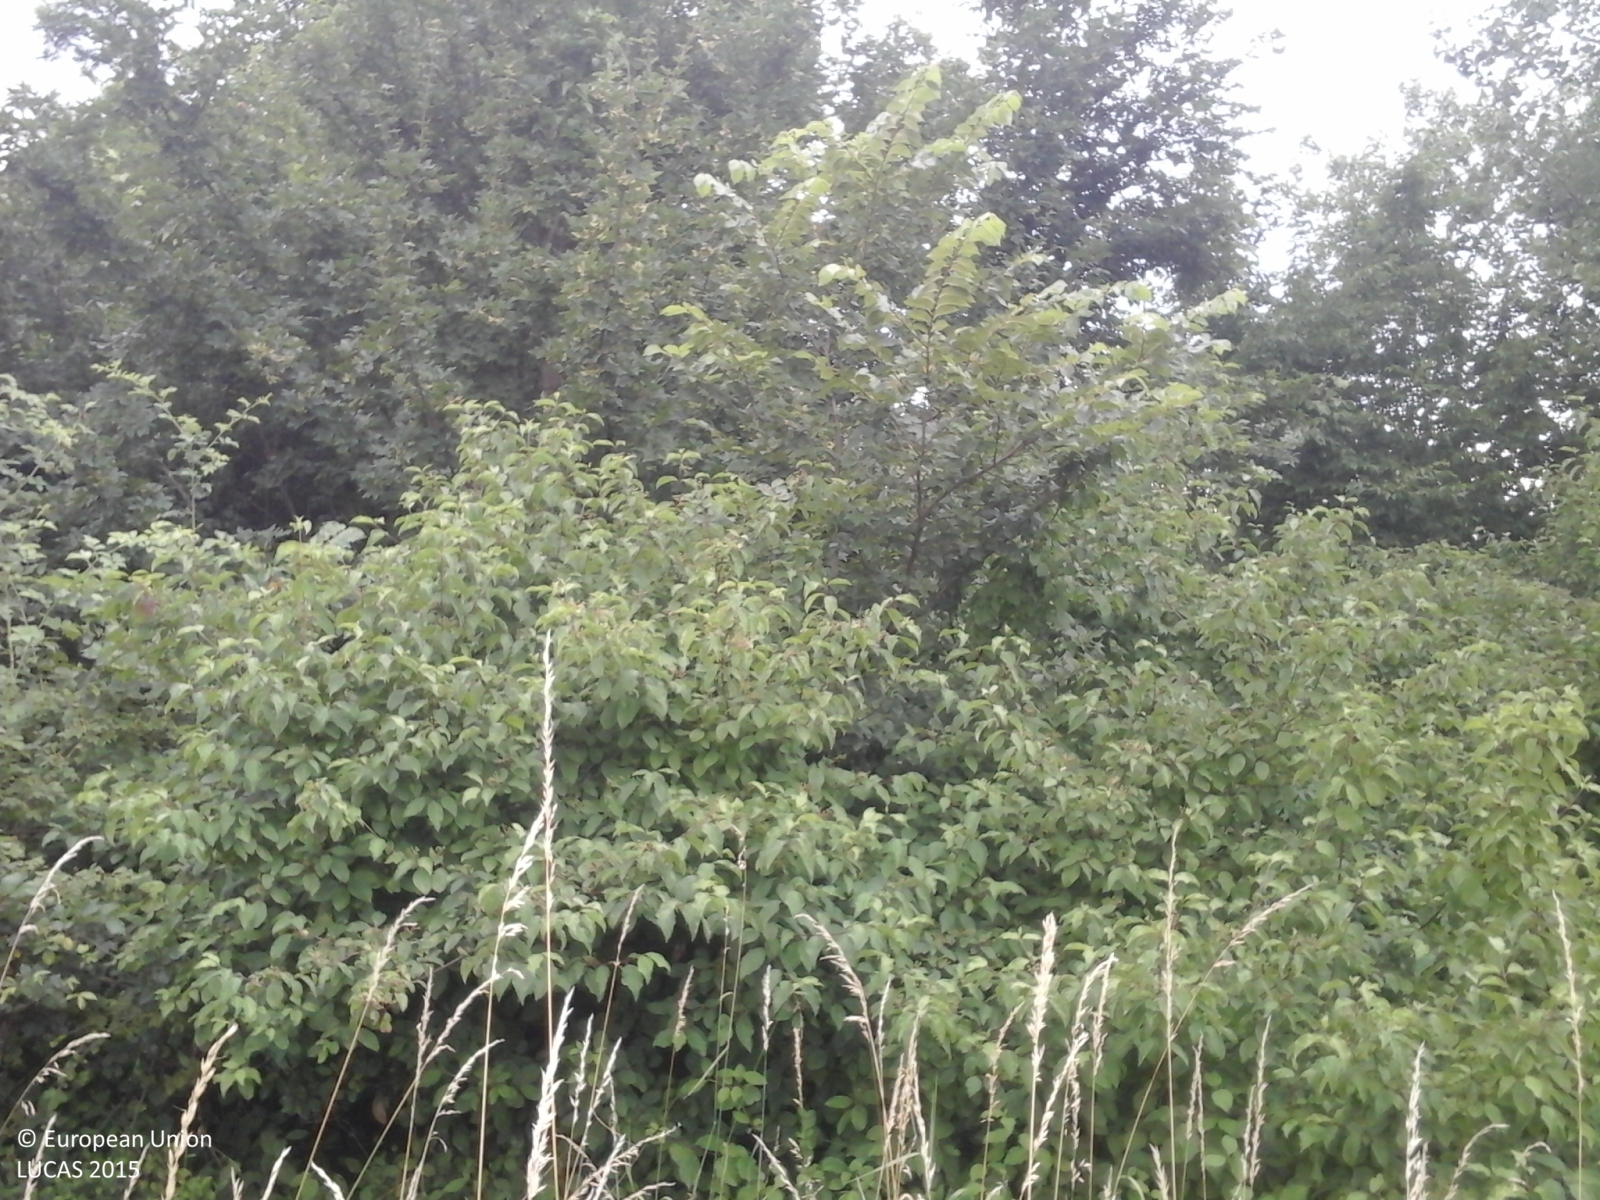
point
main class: Woodland
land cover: Broadleaved woodland
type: thermophilous deciduous forest
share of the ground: > 75 %
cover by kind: broadleaved forest trees 90 %, shrubs 10 %
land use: Forestry
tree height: > 5 m
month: June
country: IT
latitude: 44.6026
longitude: 10.2891
